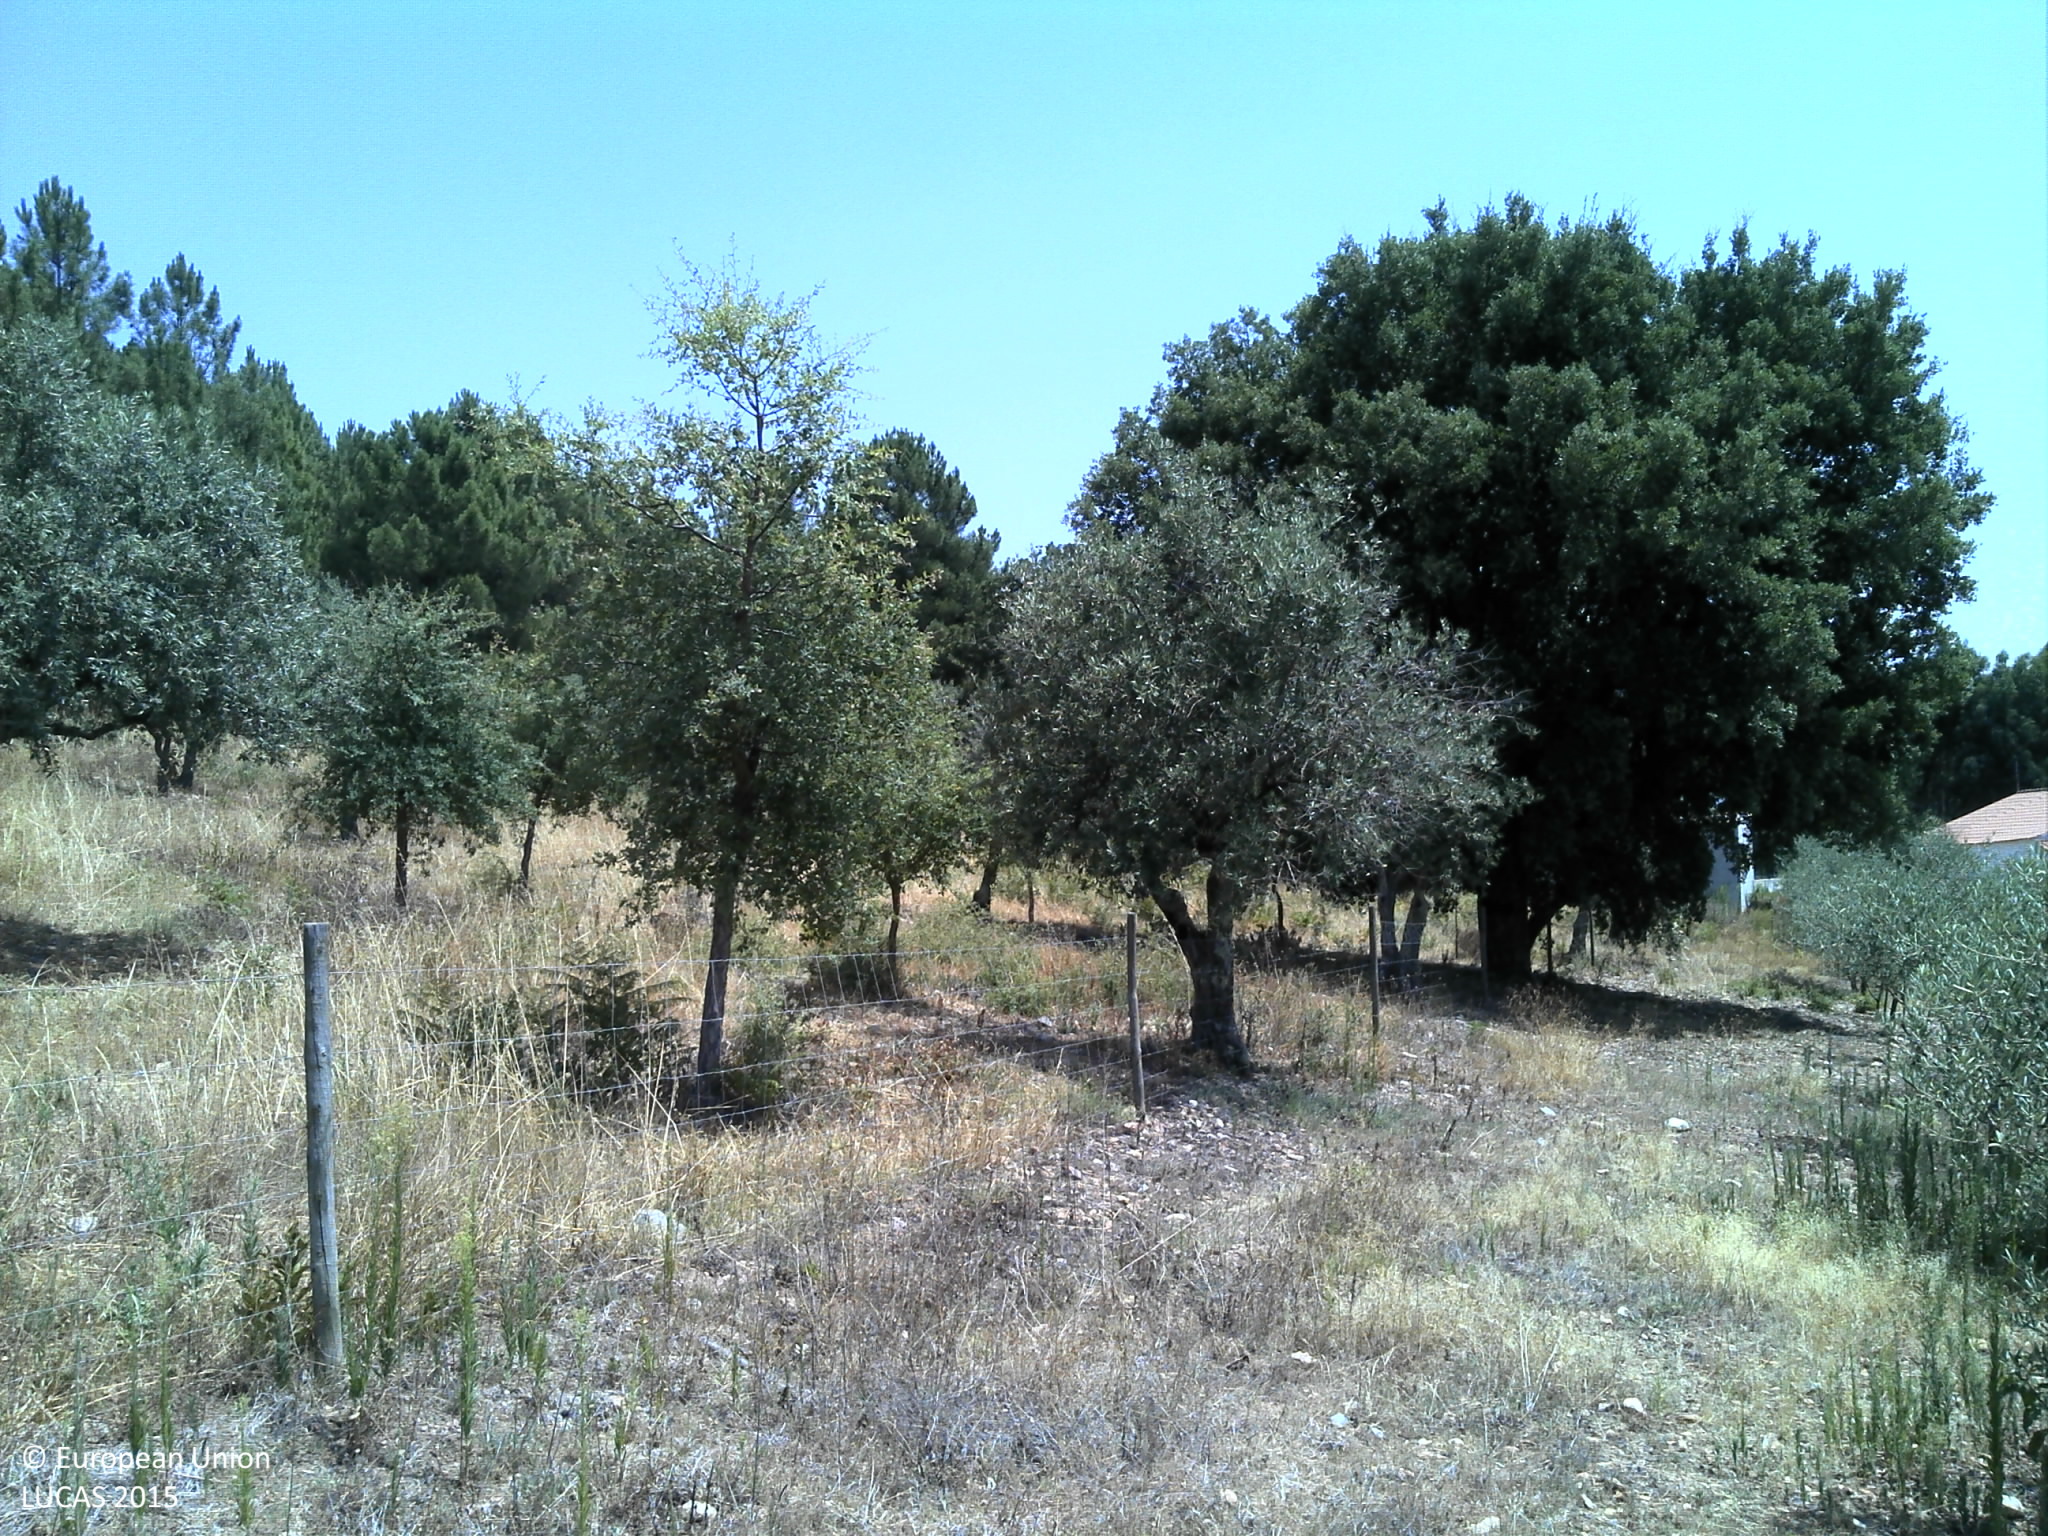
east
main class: Cropland
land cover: Olive groves
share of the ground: 10 - 25 %
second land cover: Grassland without tree/shrub cover
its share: 10 - 25 %
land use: Agriculture (excluding fallow land and kitchen gardens)
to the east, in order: Olive groves; Grassland without tree/shrub cover; Olive groves; Fences; Broadleaved woodland; Fences; Broadleaved woodland; Grassland with sparse tree/shrub cover; Pine dominated coniferous woodland; Fences; Pine dominated mixed woodland; Tracks
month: August
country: PT
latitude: 39.2767
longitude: -7.3697
